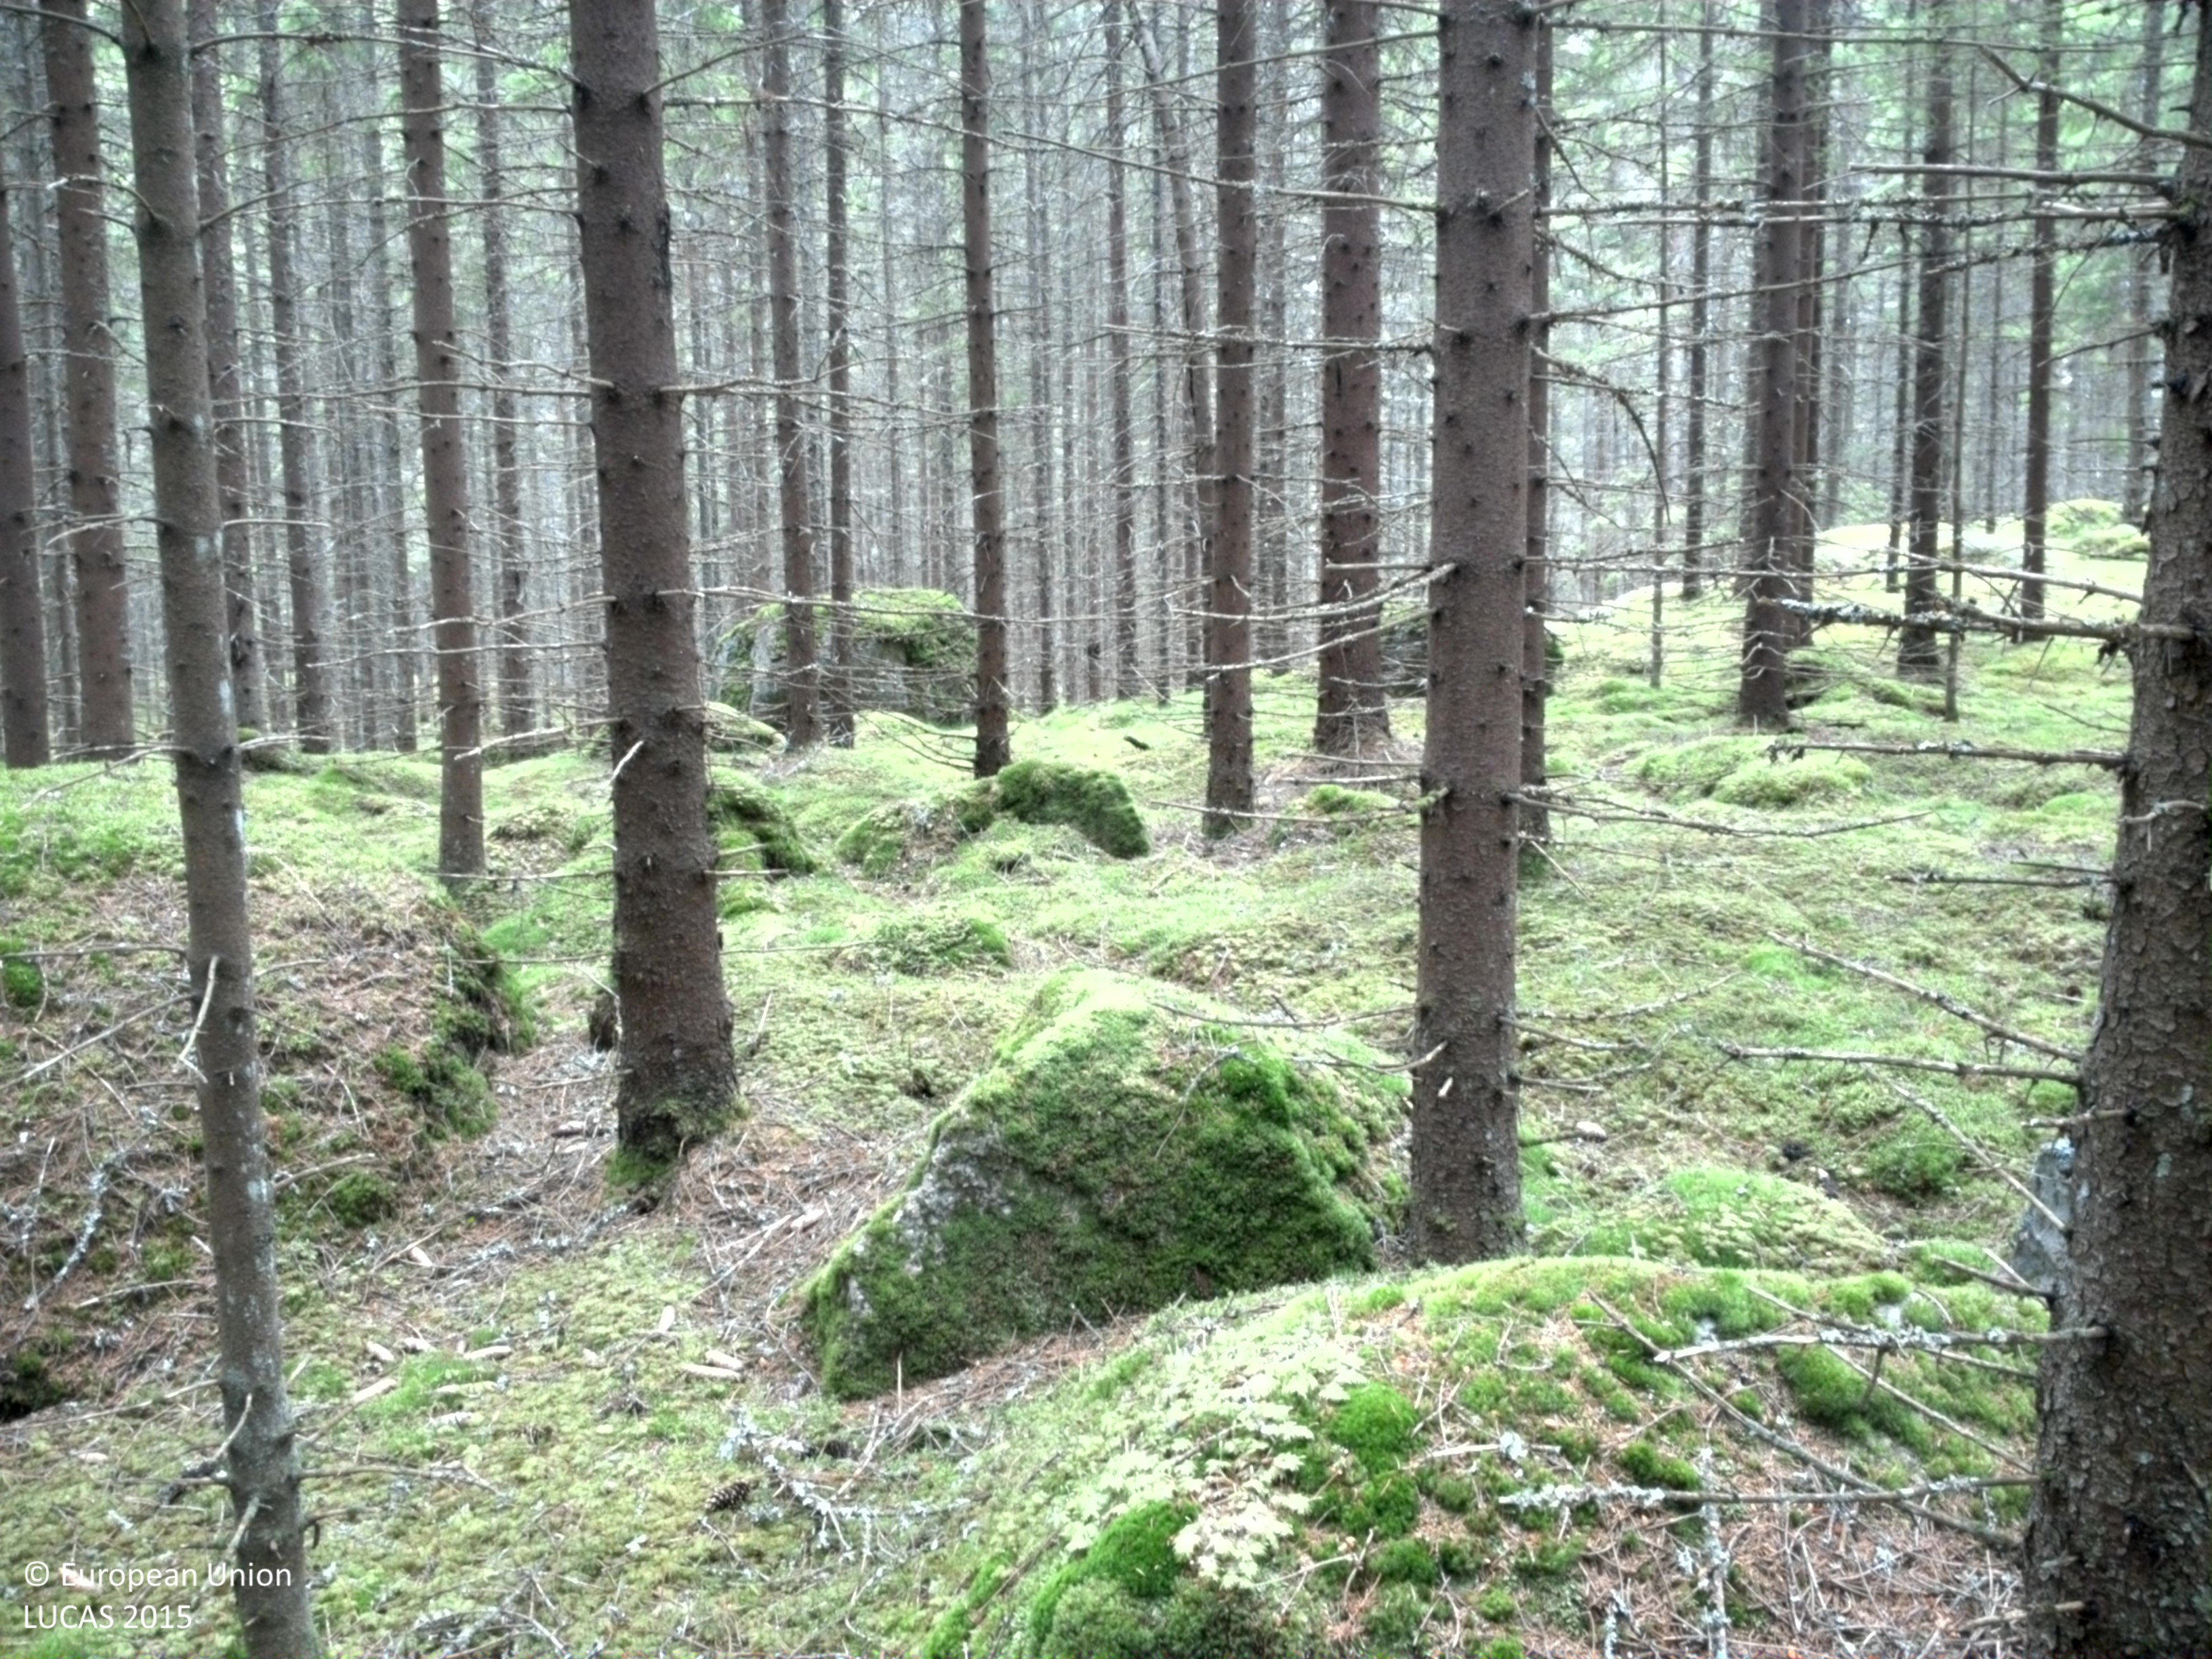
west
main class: Woodland
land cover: Spruce dominated coniferous woodland
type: boreal forest
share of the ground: > 75 %
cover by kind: coniferous forest trees 80 %, lichens and mosses 20 %
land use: Forestry
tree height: > 5 m
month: July
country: SE
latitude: 59.4792
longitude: 14.4574
